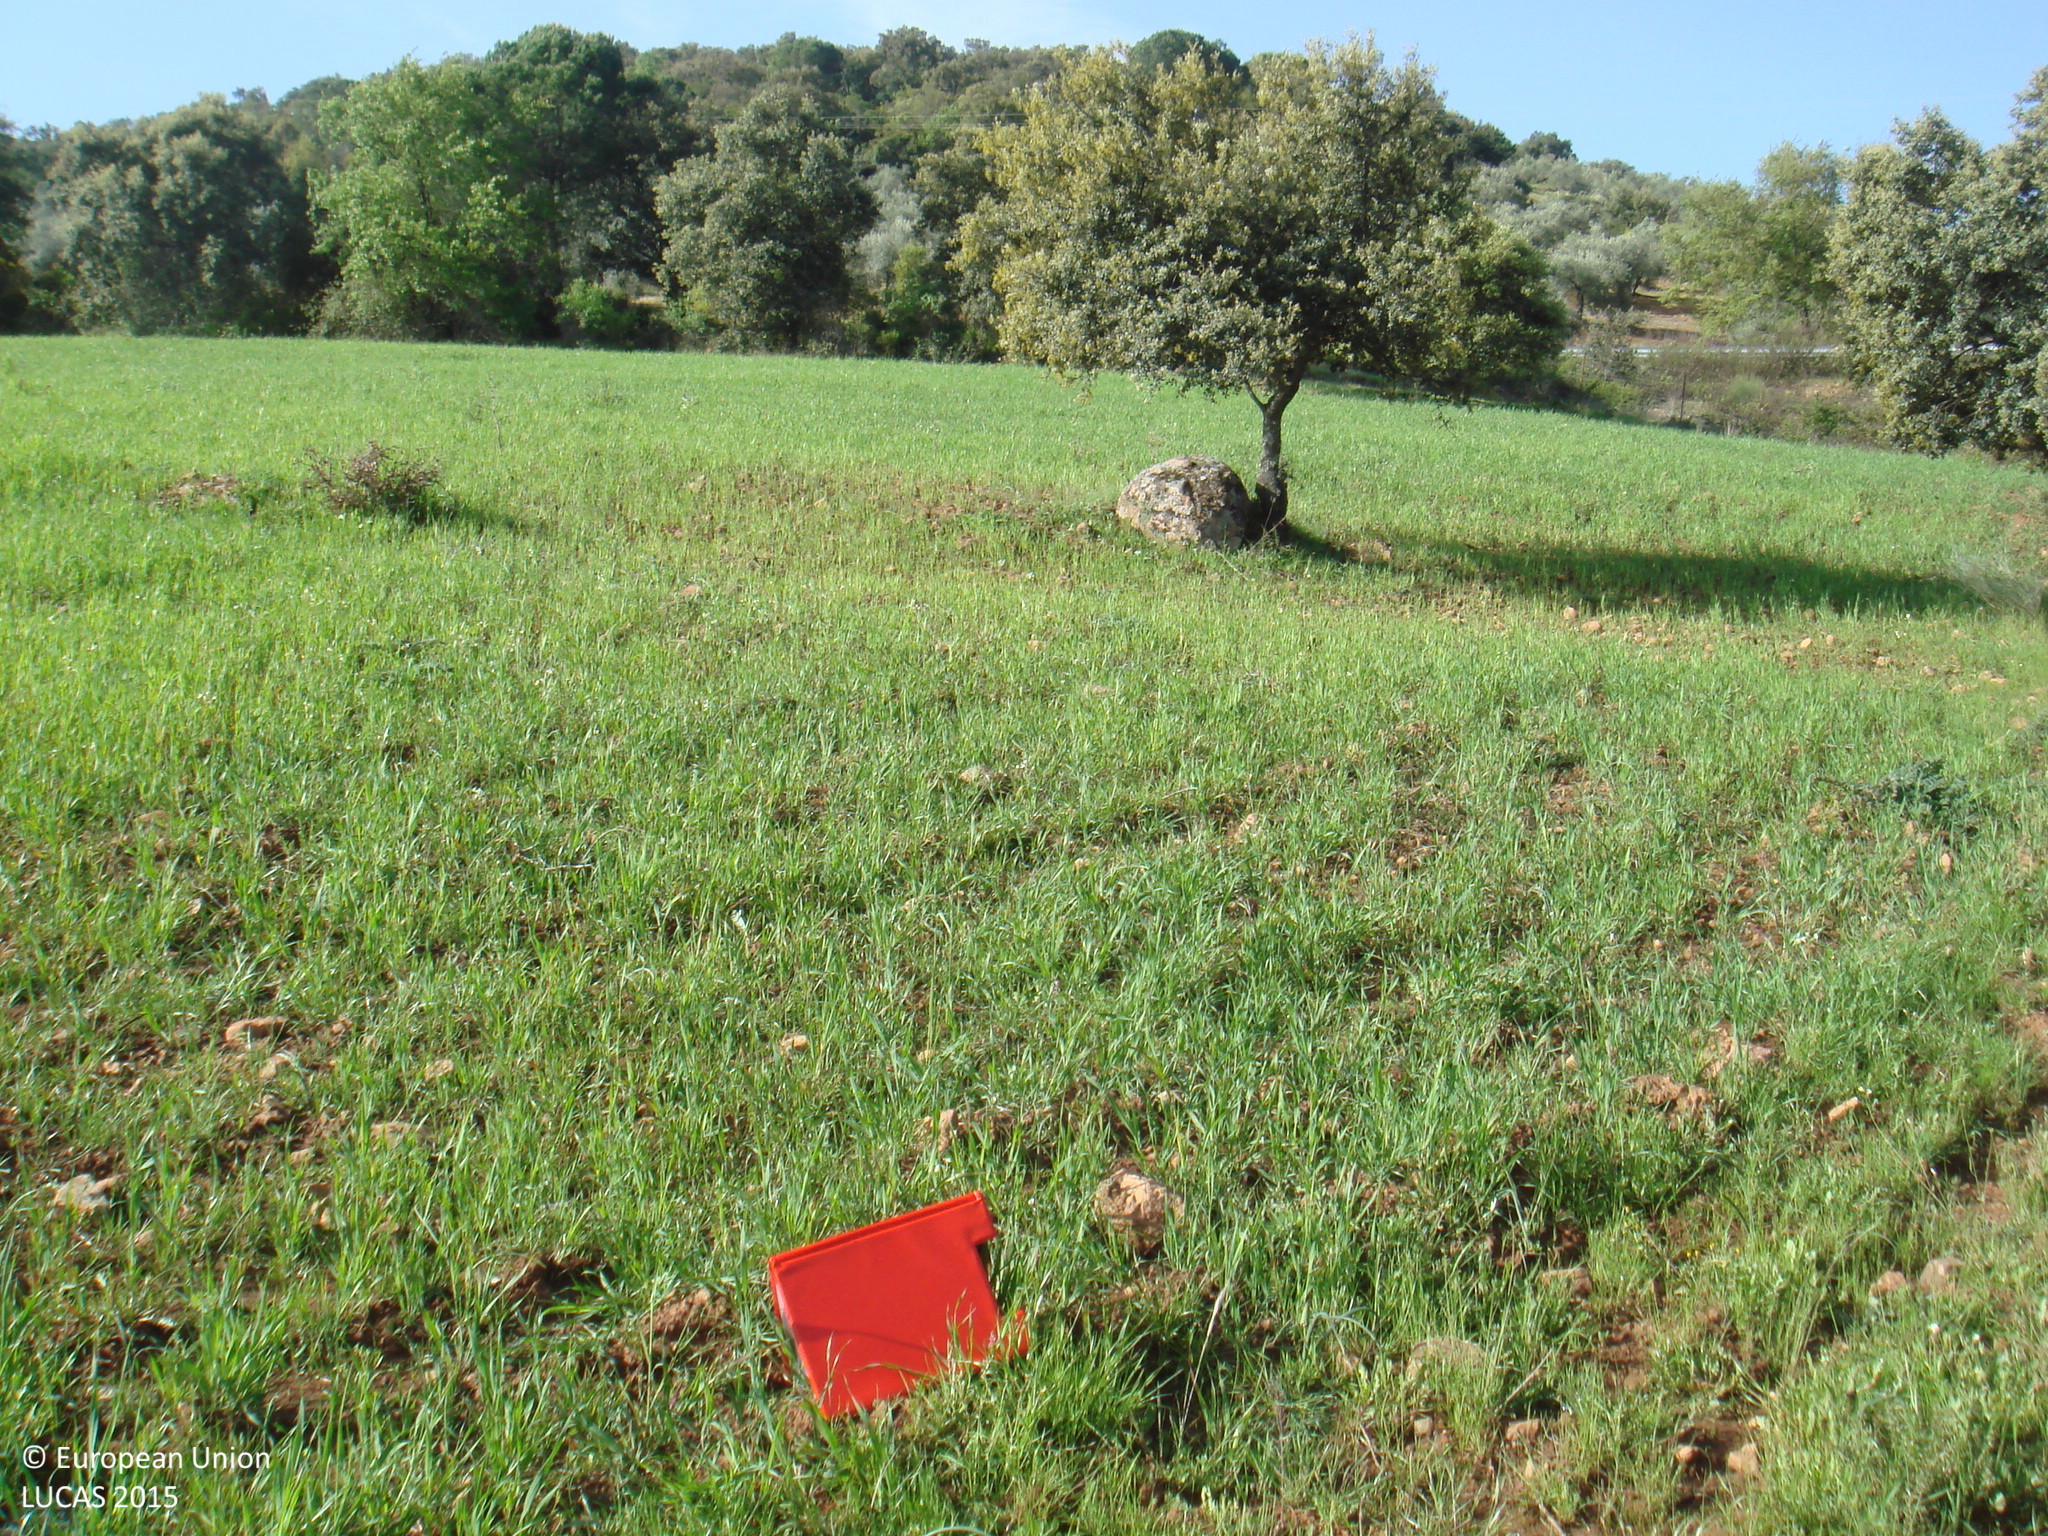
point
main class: Cropland
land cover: Oats
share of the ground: > 75 %
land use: Agriculture (excluding fallow land and kitchen gardens)
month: April
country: ES
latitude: 38.1042
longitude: -5.0641
